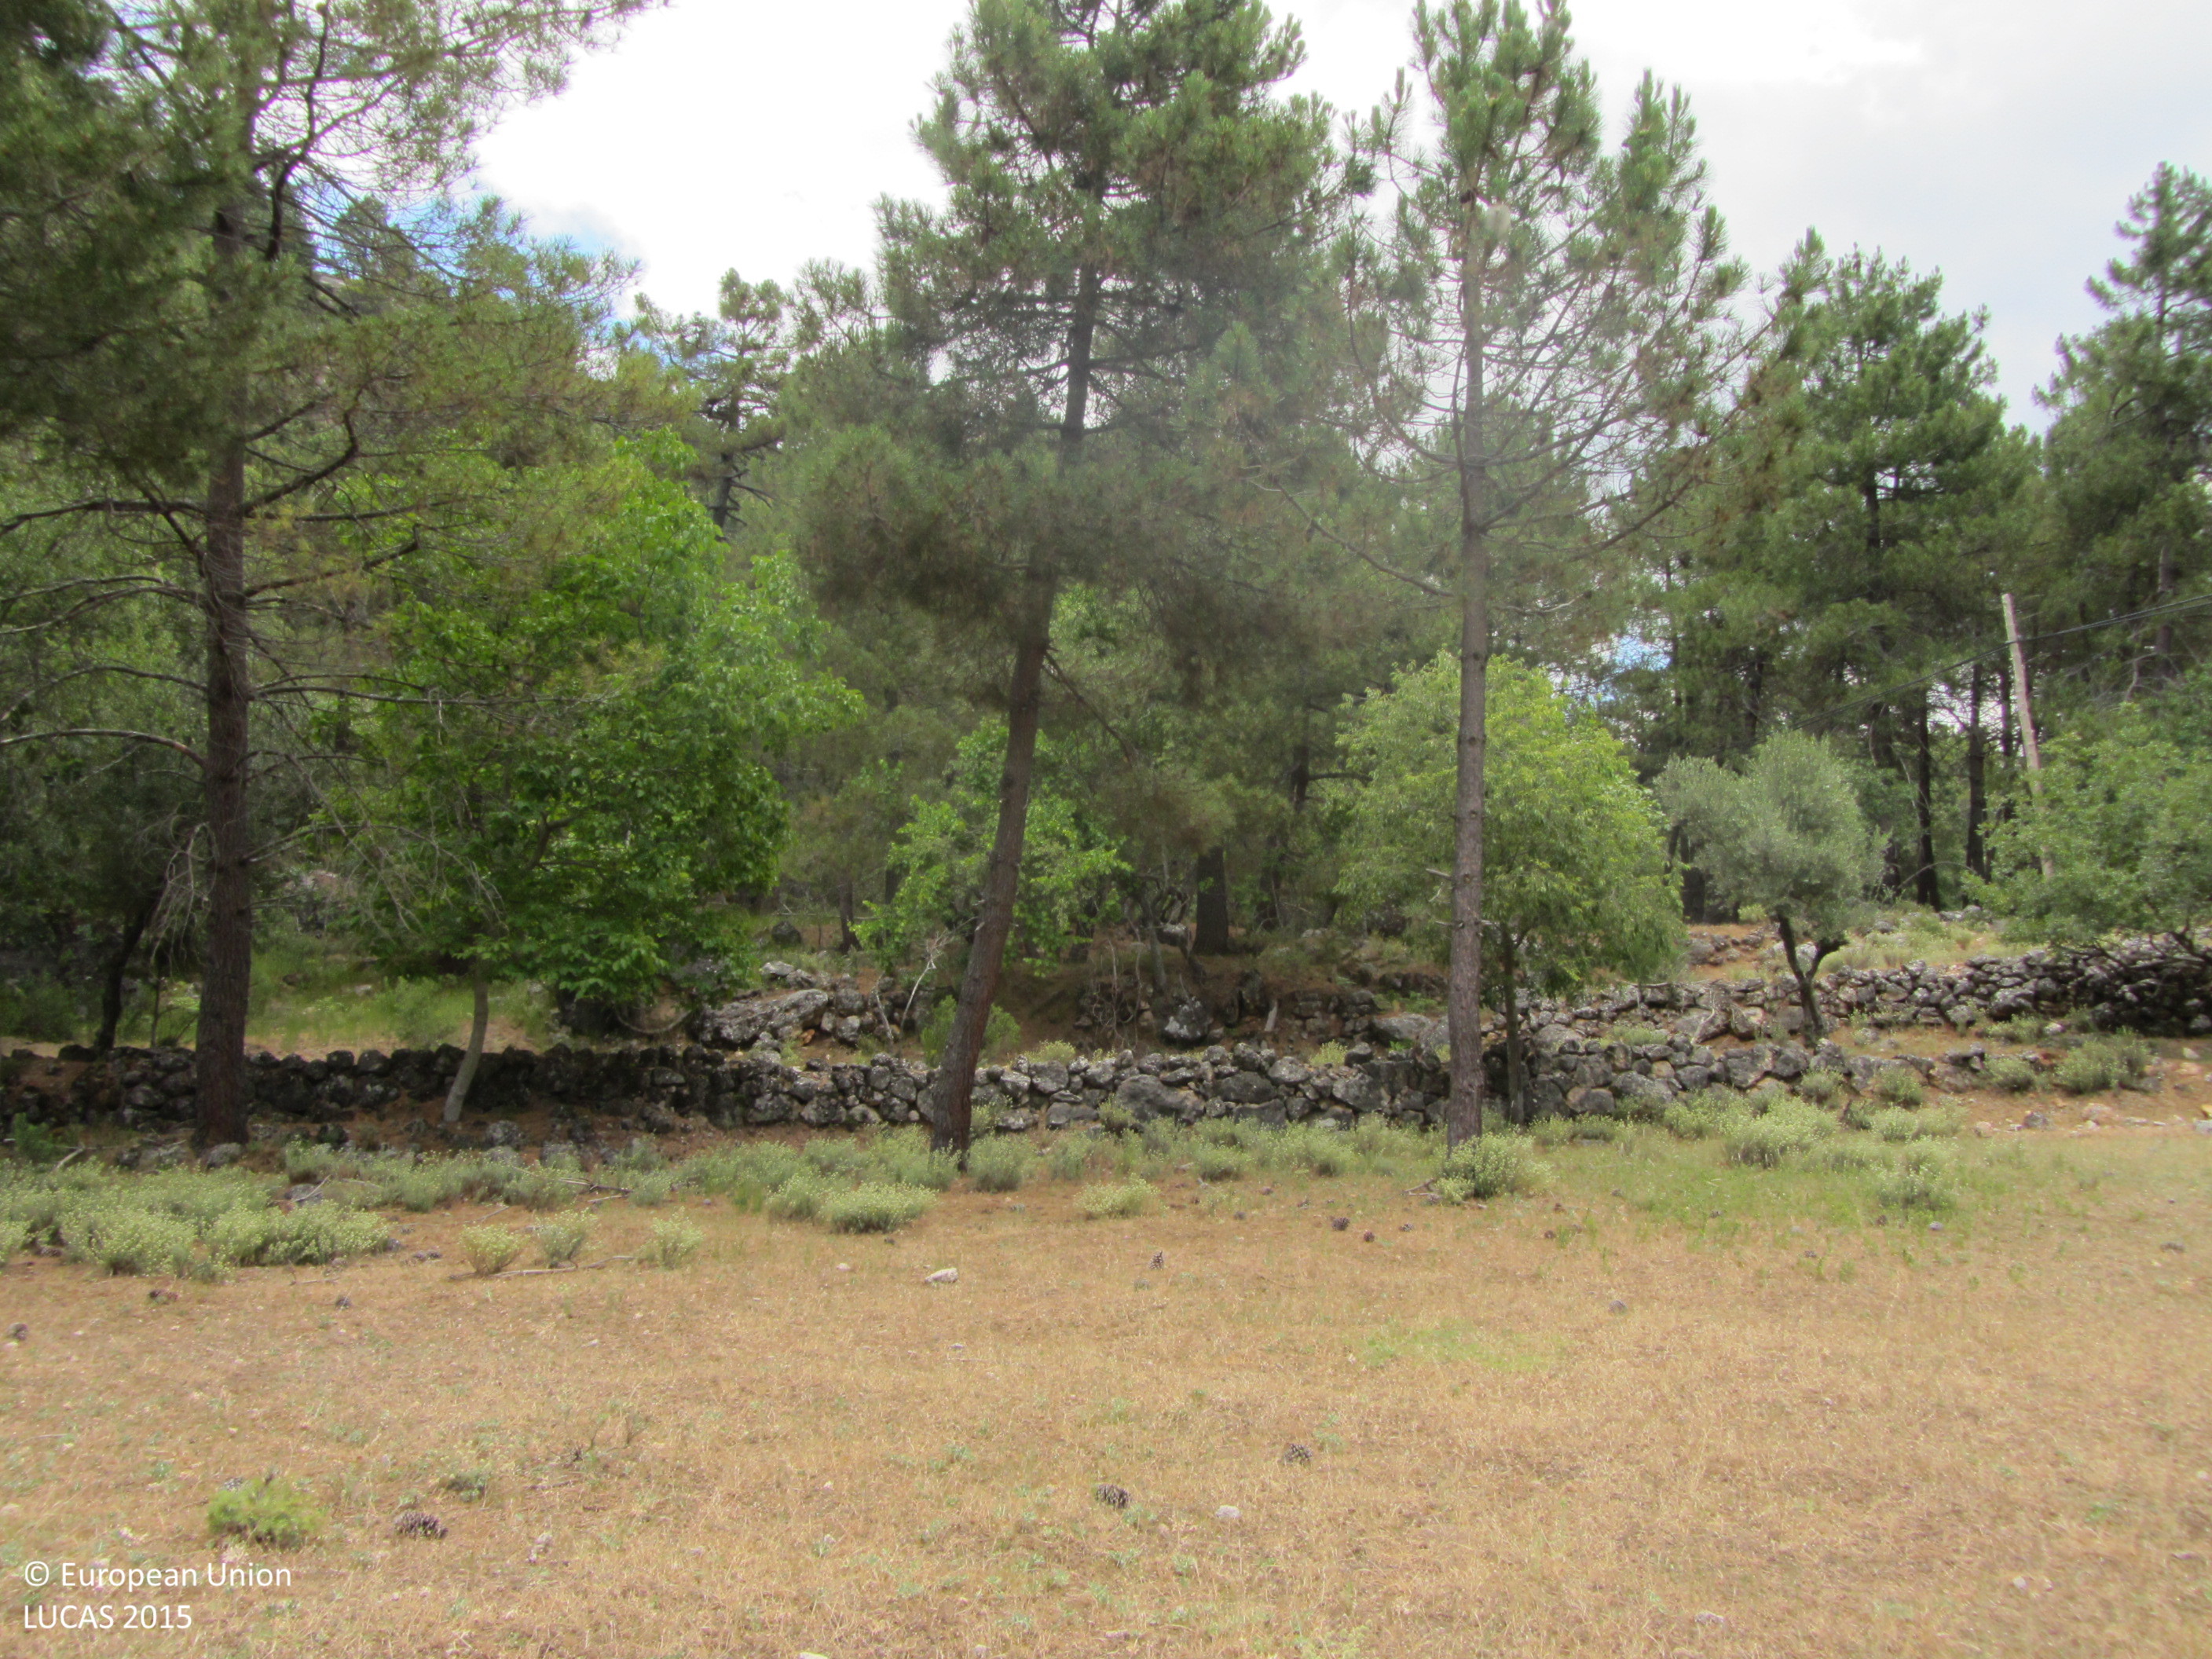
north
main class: Woodland
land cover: Pine dominated mixed woodland
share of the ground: > 75 %
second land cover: Grassland without tree/shrub cover
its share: > 75 %
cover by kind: herbaceous plants 60 %, broadleaved forest trees 20 %, coniferous forest trees 10 %, consolidated bare surface 10 %
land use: Forestry
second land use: Agriculture (excluding fallow land and kitchen gardens)
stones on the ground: < 10 %
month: June
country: ES
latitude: 37.9213
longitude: -2.9519
